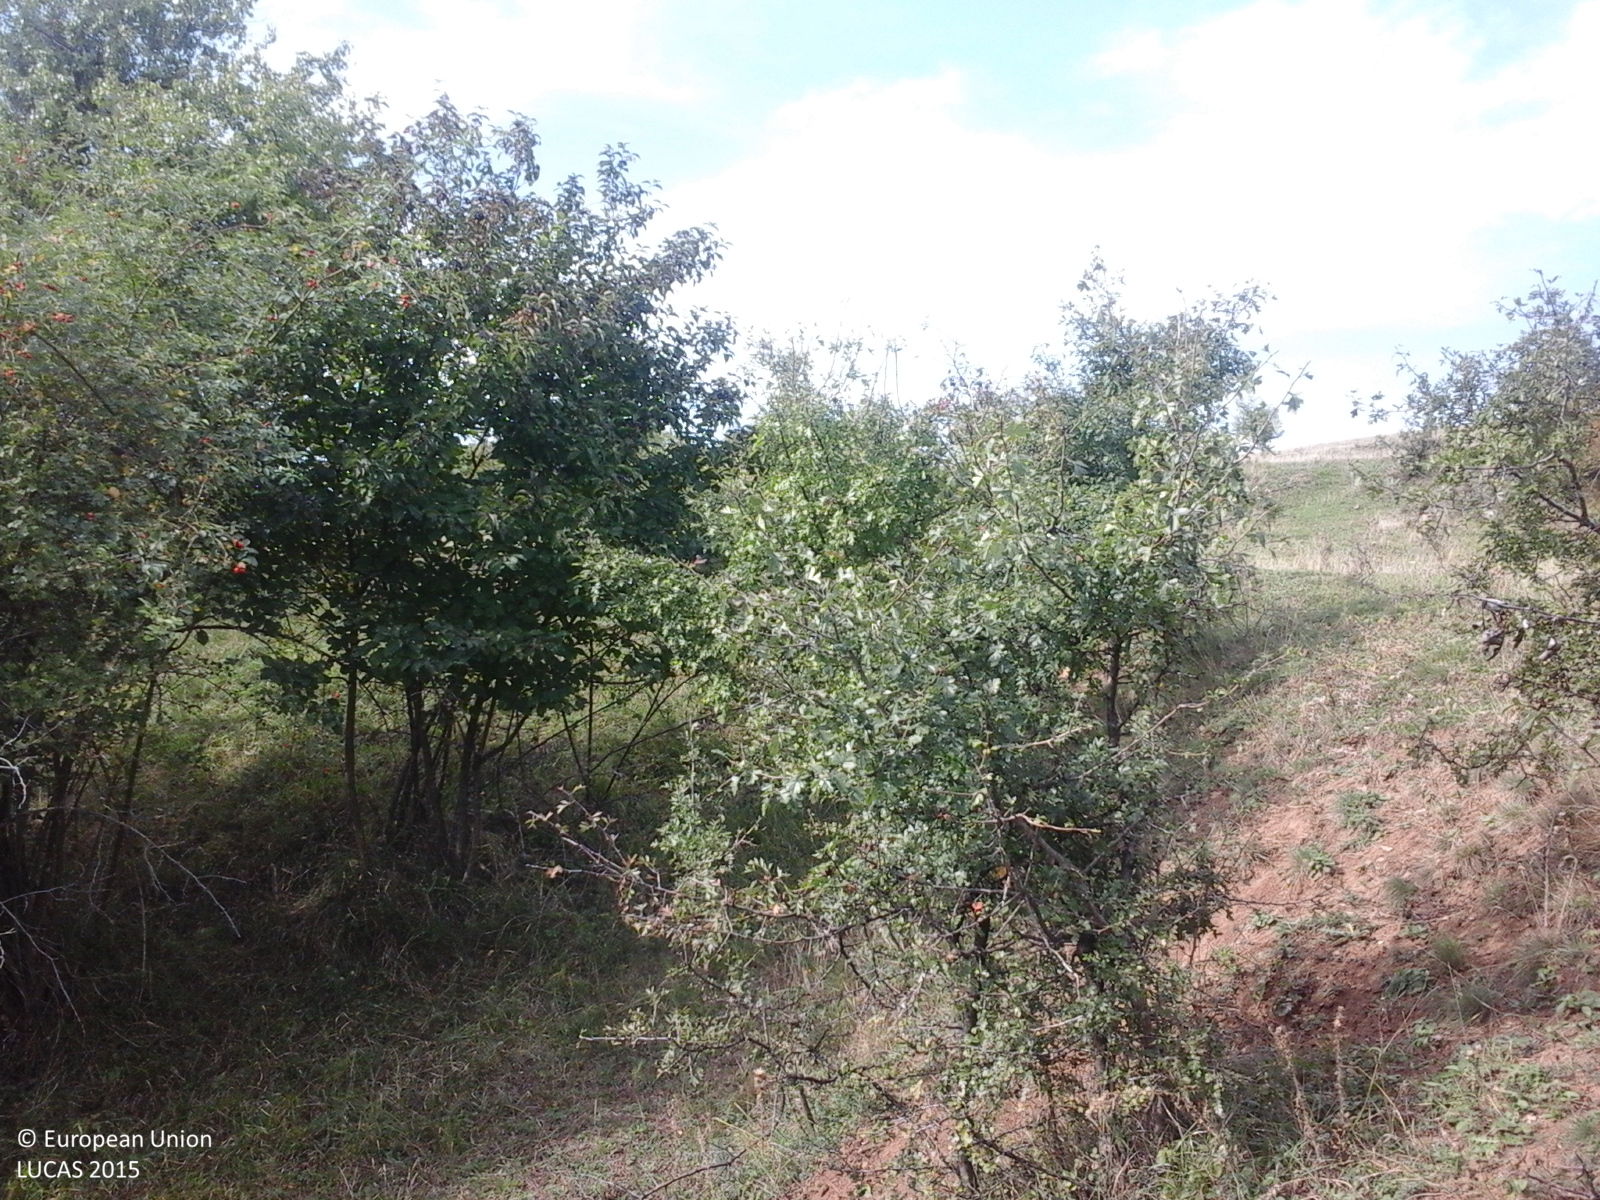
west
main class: Grassland
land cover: Grassland with sparse tree/shrub cover
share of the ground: > 75 %
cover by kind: herbaceous plants 85 %, shrubs 10 %, broadleaved forest trees 5 %
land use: Agriculture (excluding fallow land and kitchen gardens)
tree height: < 5 m
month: September
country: RO
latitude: 46.6776
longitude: 23.4945
